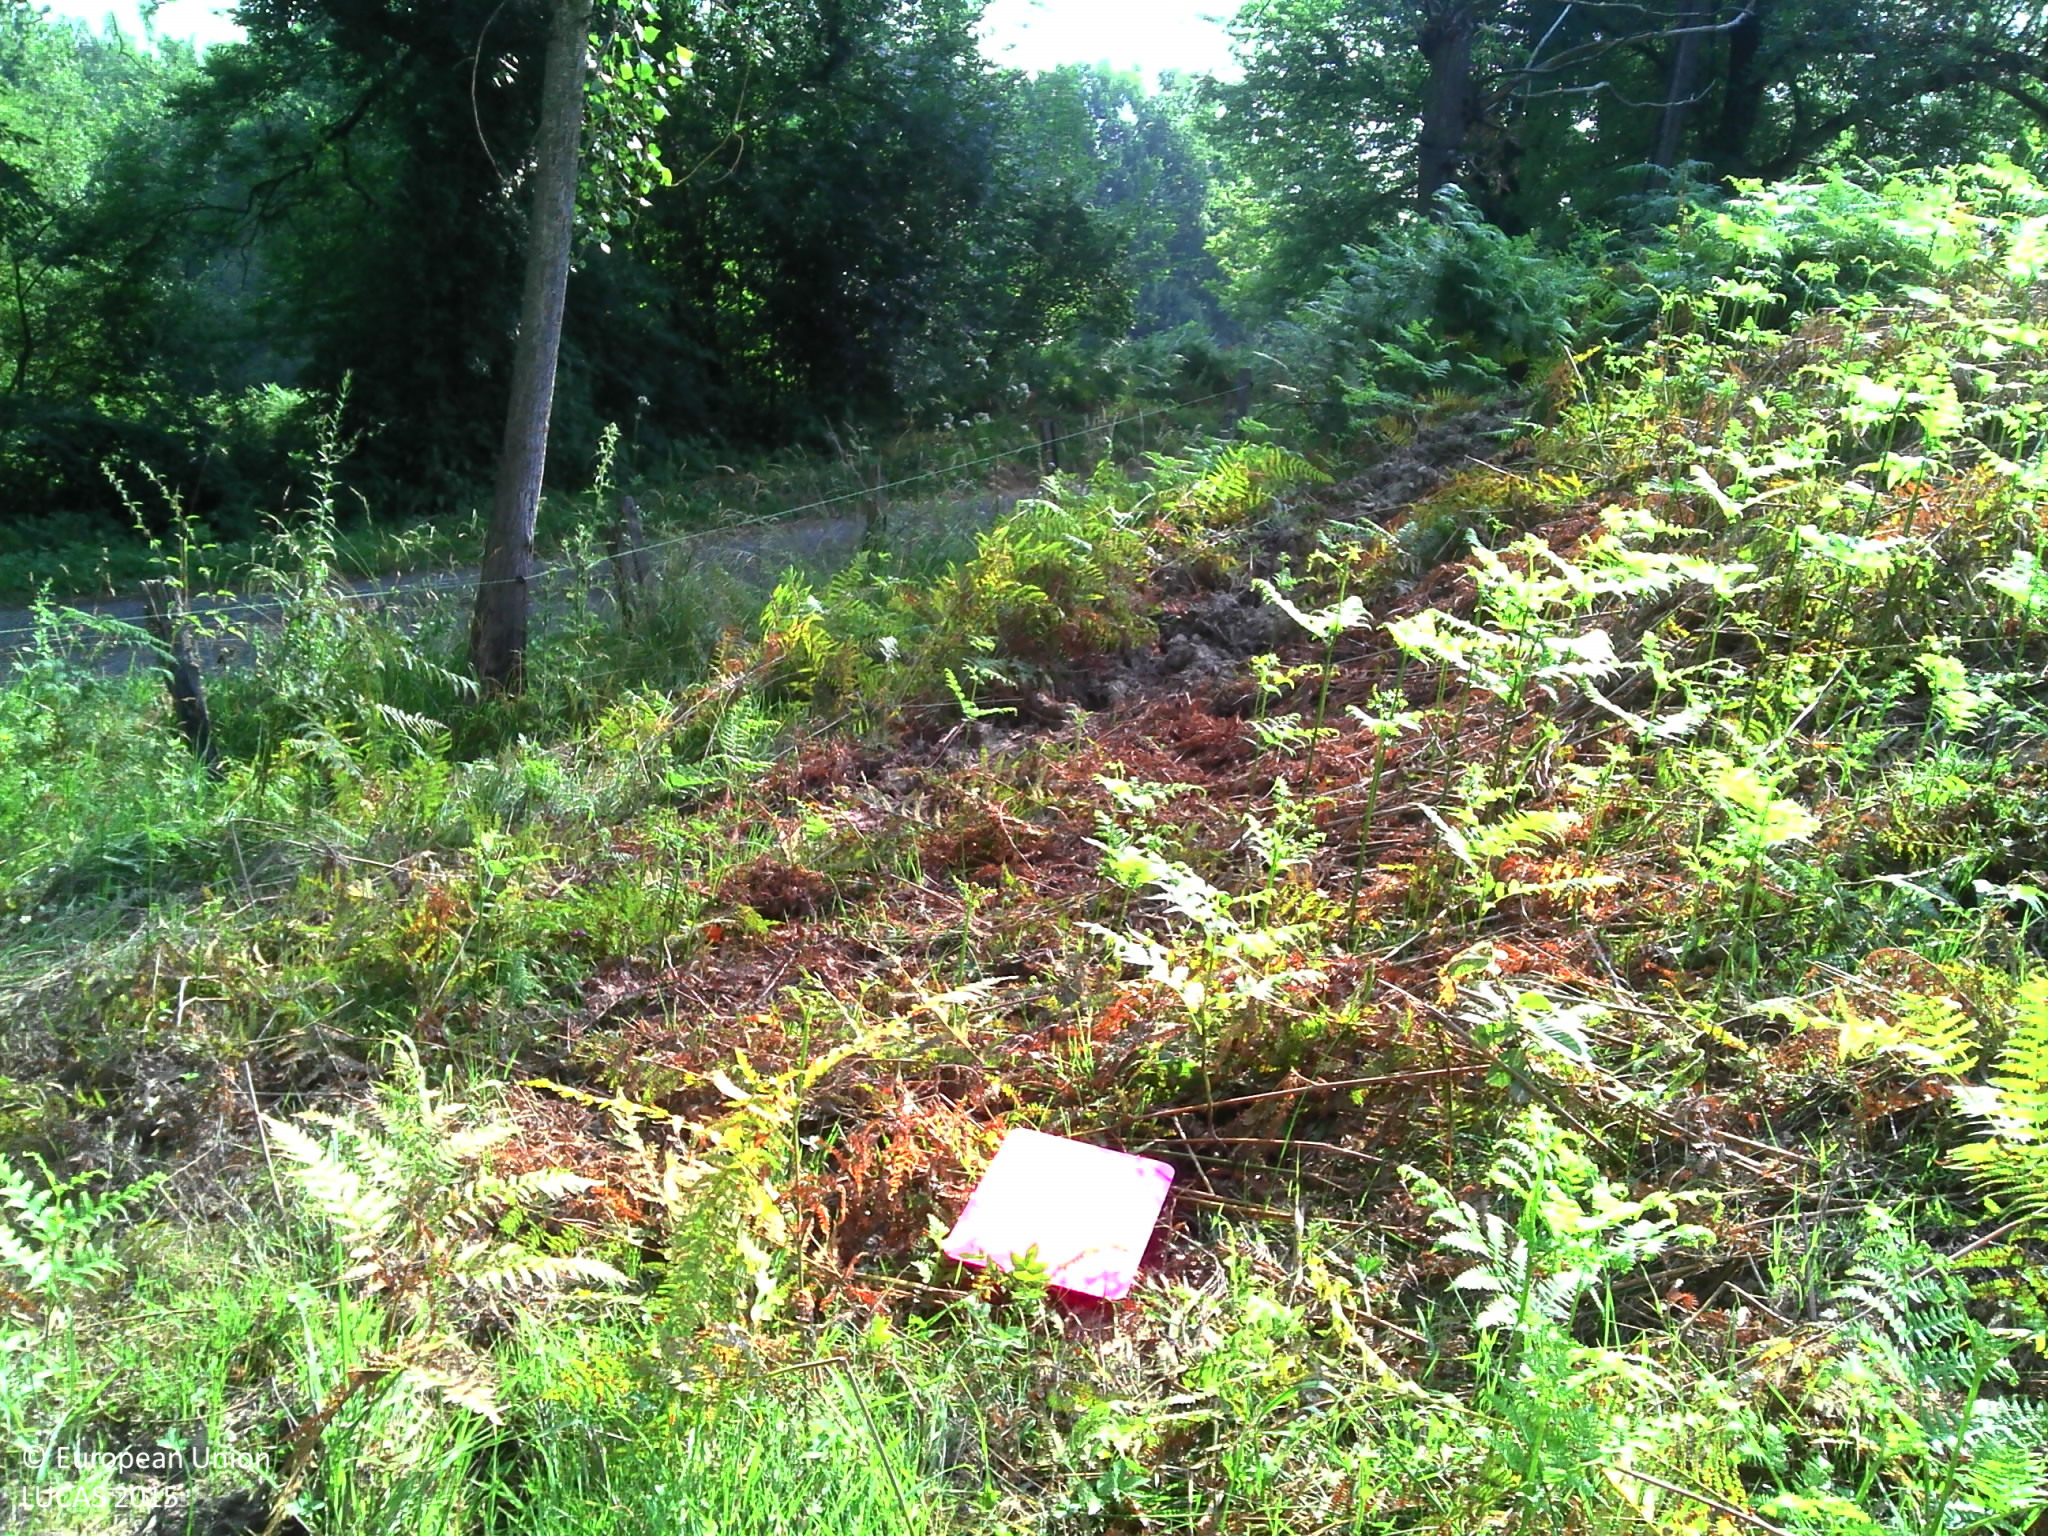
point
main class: Grassland
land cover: Spontaneously vegetated surfaces
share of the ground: > 75 %
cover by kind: herbaceous plants 100 %
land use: Agriculture (excluding fallow land and kitchen gardens)
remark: Temporary dry
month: July
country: FR
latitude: 43.0047
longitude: 1.0858
